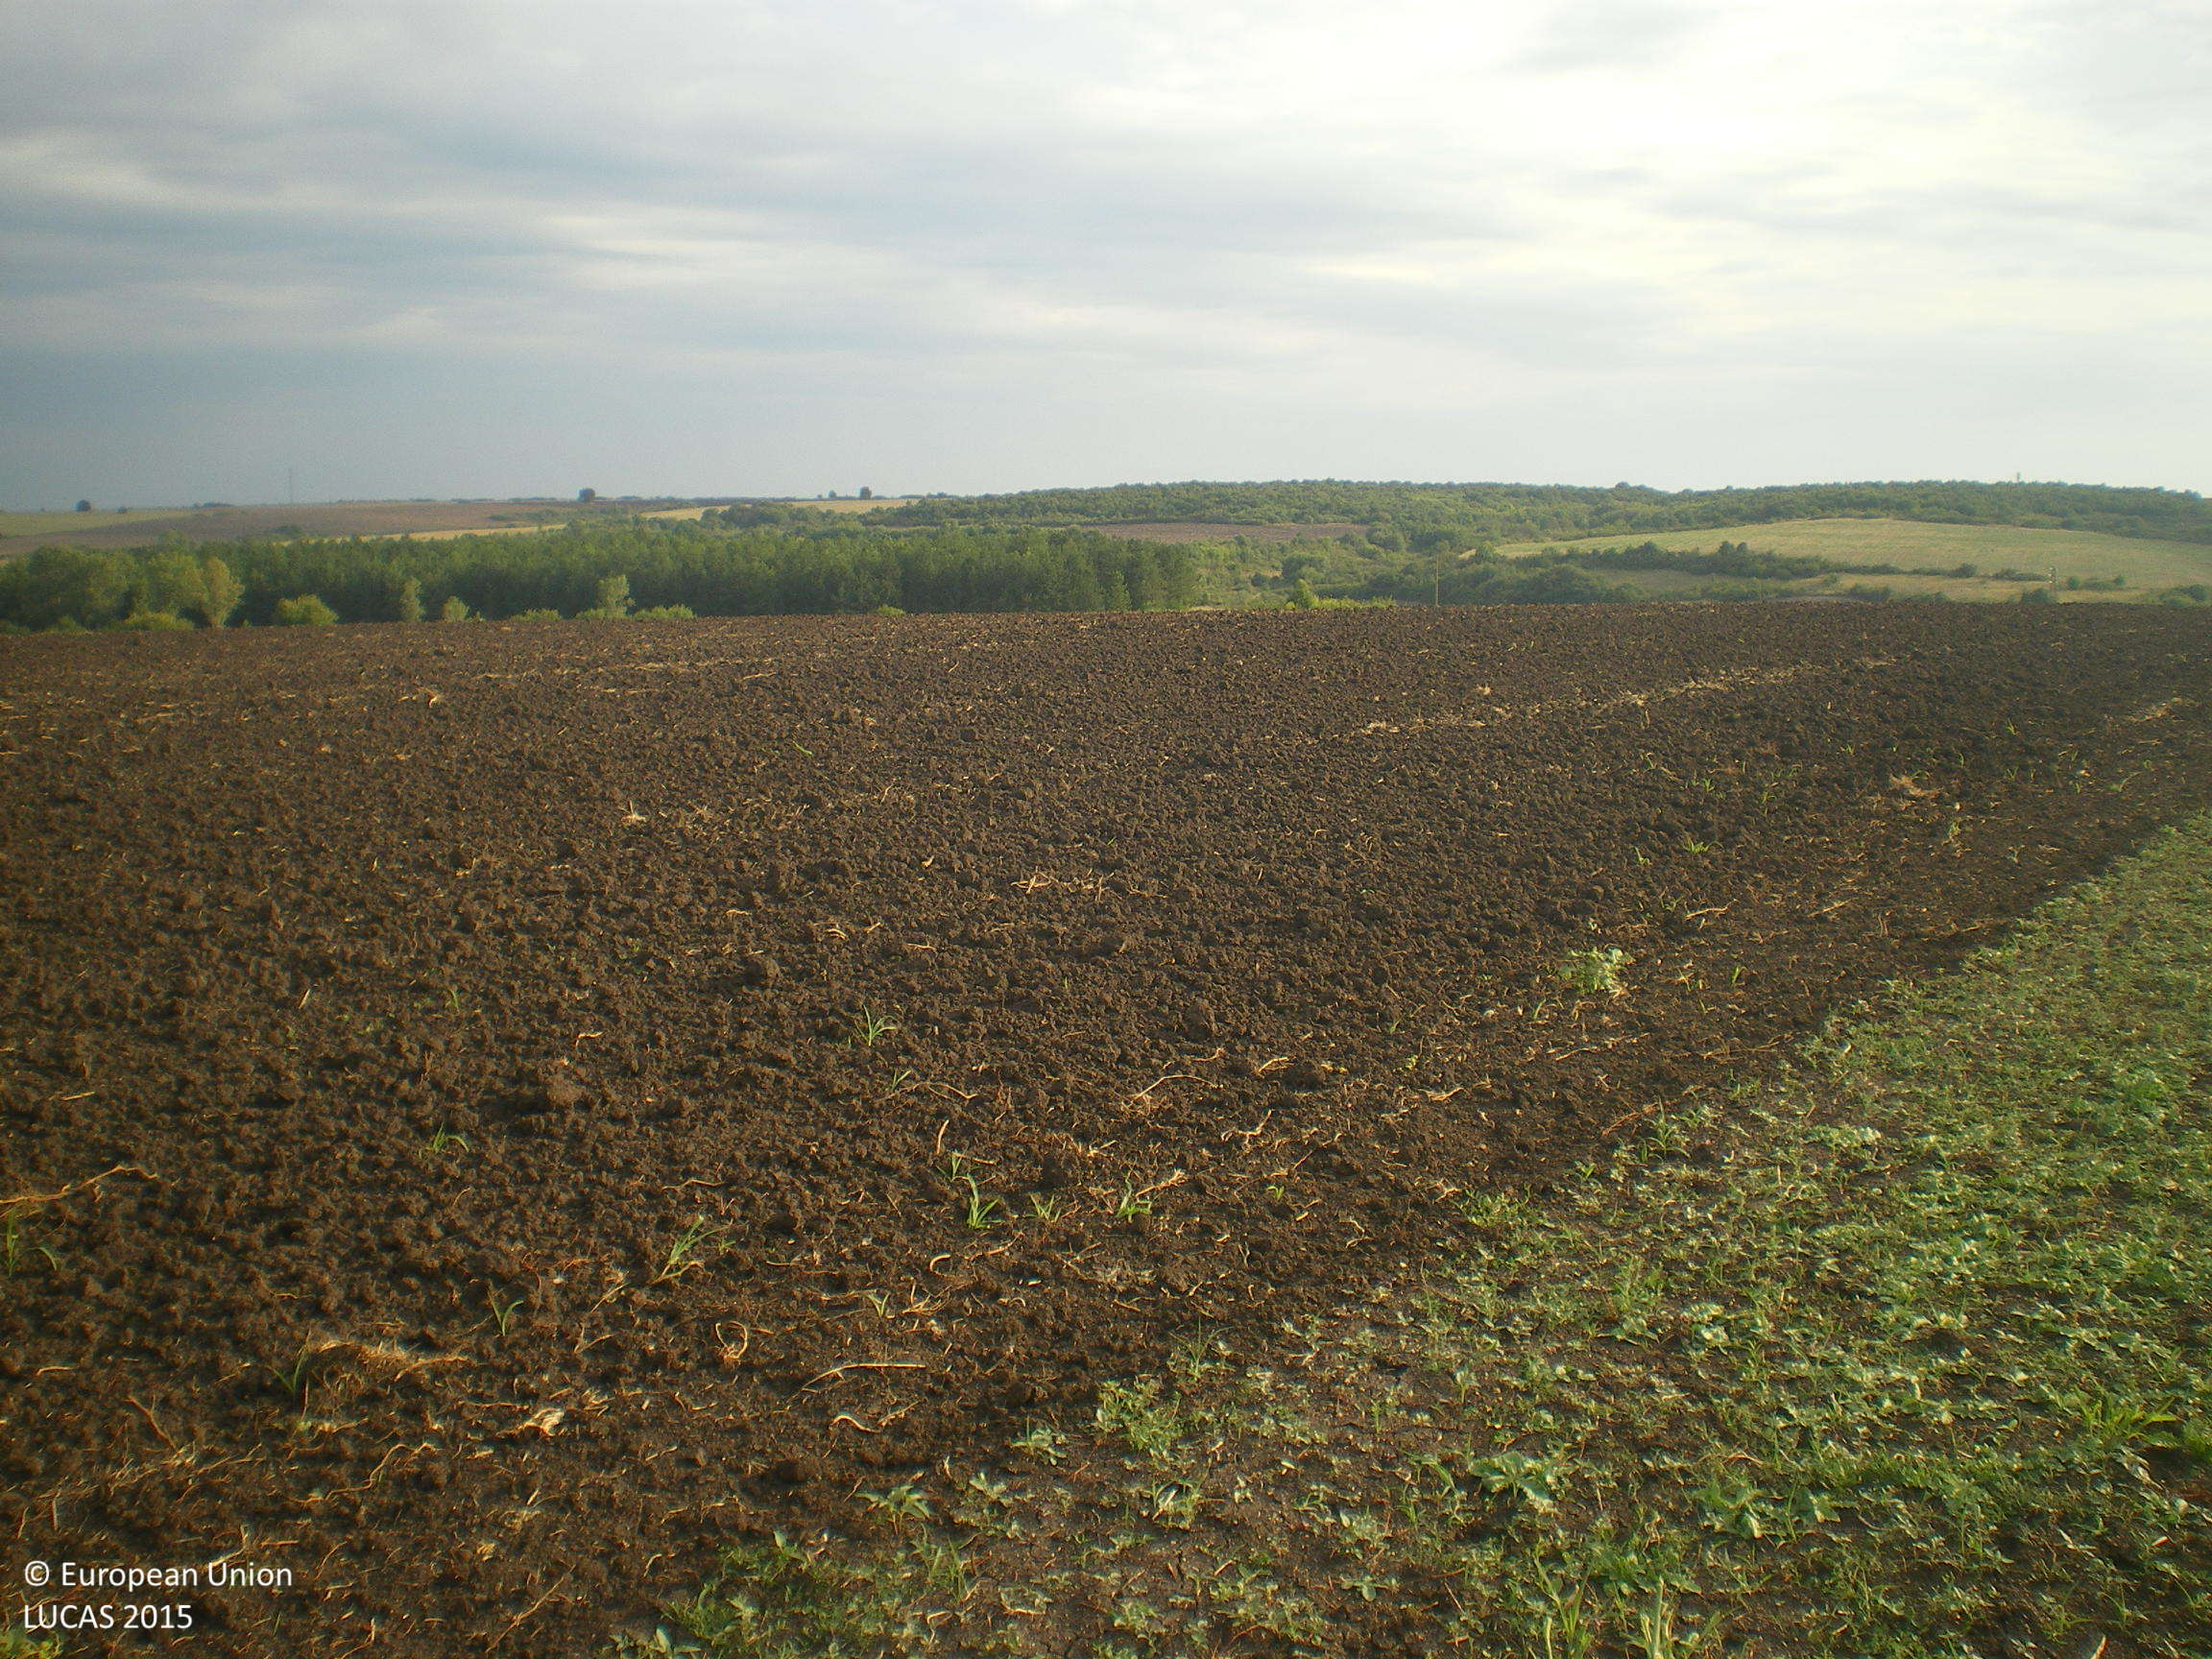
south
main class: Grassland
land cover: Spontaneously vegetated surfaces
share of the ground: 10 - 25 %
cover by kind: herbaceous plants 60 %, consolidated bare surface 40 %
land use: Agriculture (excluding fallow land and kitchen gardens)
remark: Harvested field
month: September
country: BG
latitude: 42.2117
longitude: 25.8078
